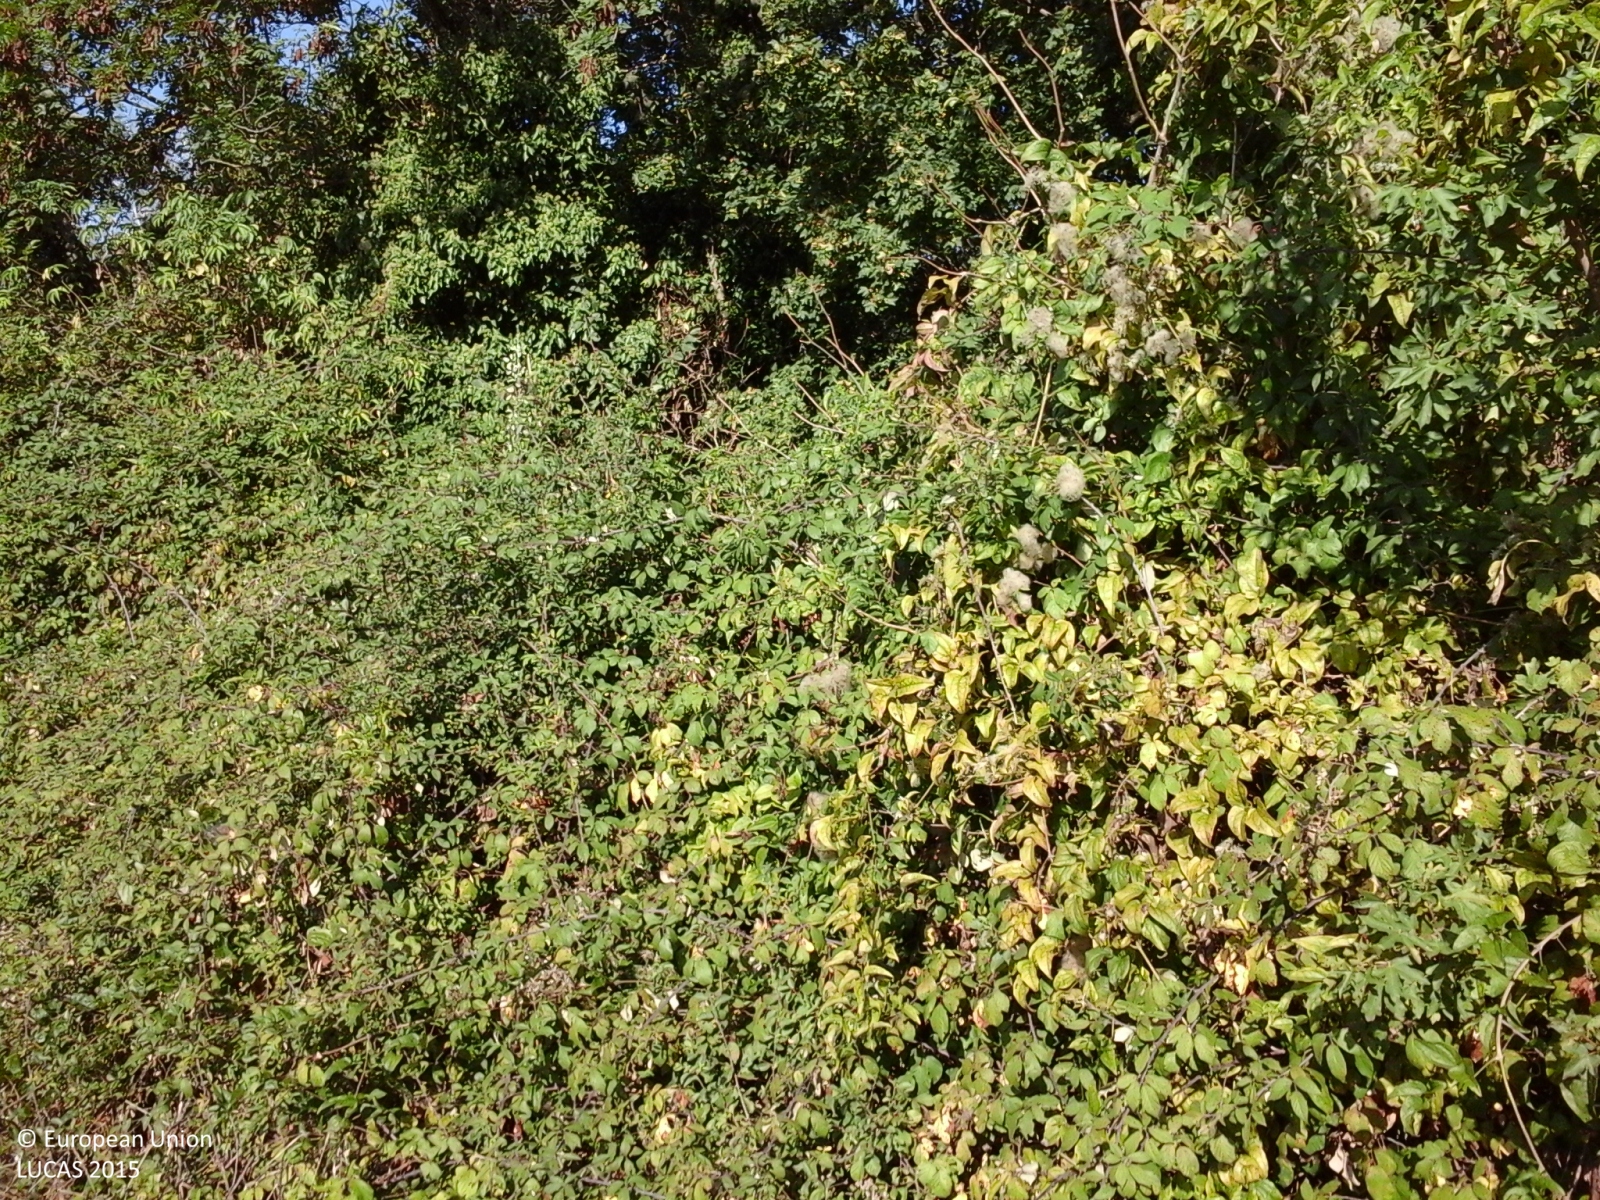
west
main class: Cropland
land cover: Durum wheat
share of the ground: < 10 %
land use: Agriculture (excluding fallow land and kitchen gardens)
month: September
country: IT
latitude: 43.2785
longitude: 12.9864
